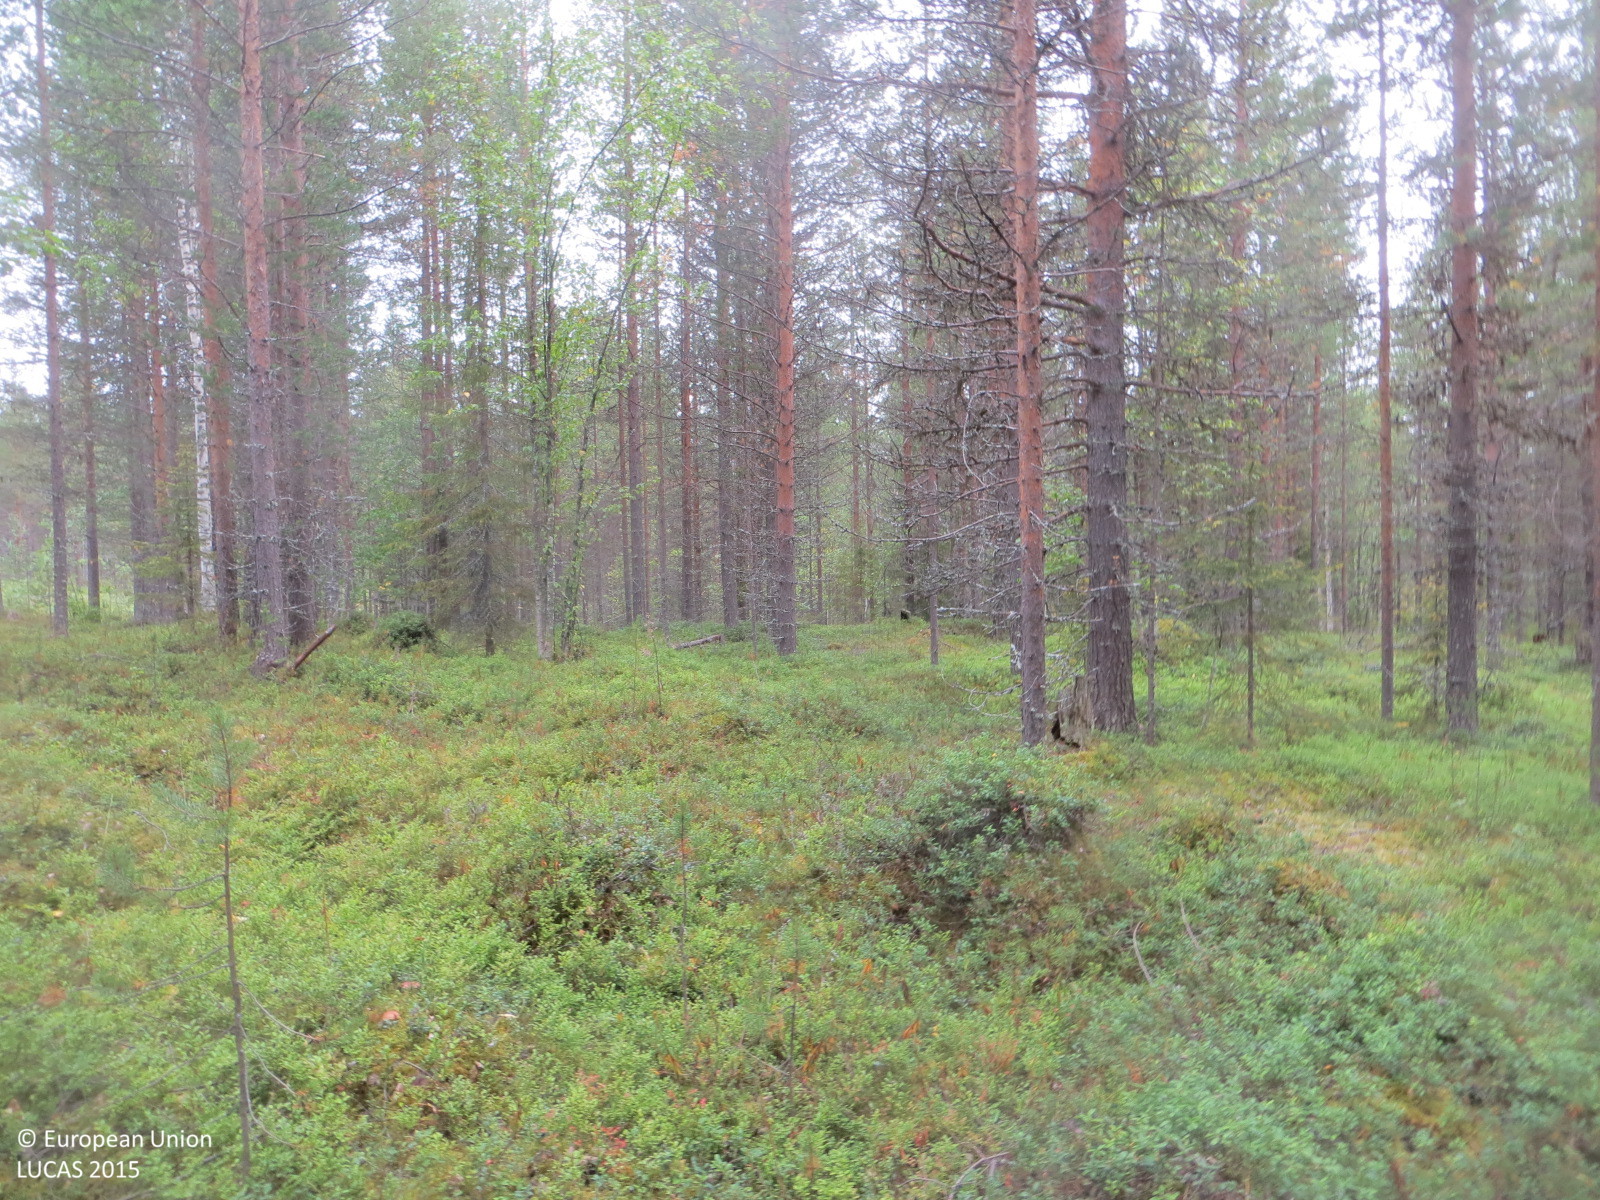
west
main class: Woodland
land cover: Pine dominated mixed woodland
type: boreal forest
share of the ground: 50 - 75 %
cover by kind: coniferous forest trees 45 %, shrubs 40 %, broadleaved forest trees 15 %
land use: Forestry
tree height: > 5 m
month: August
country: FI
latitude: 67.4198
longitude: 24.2877
